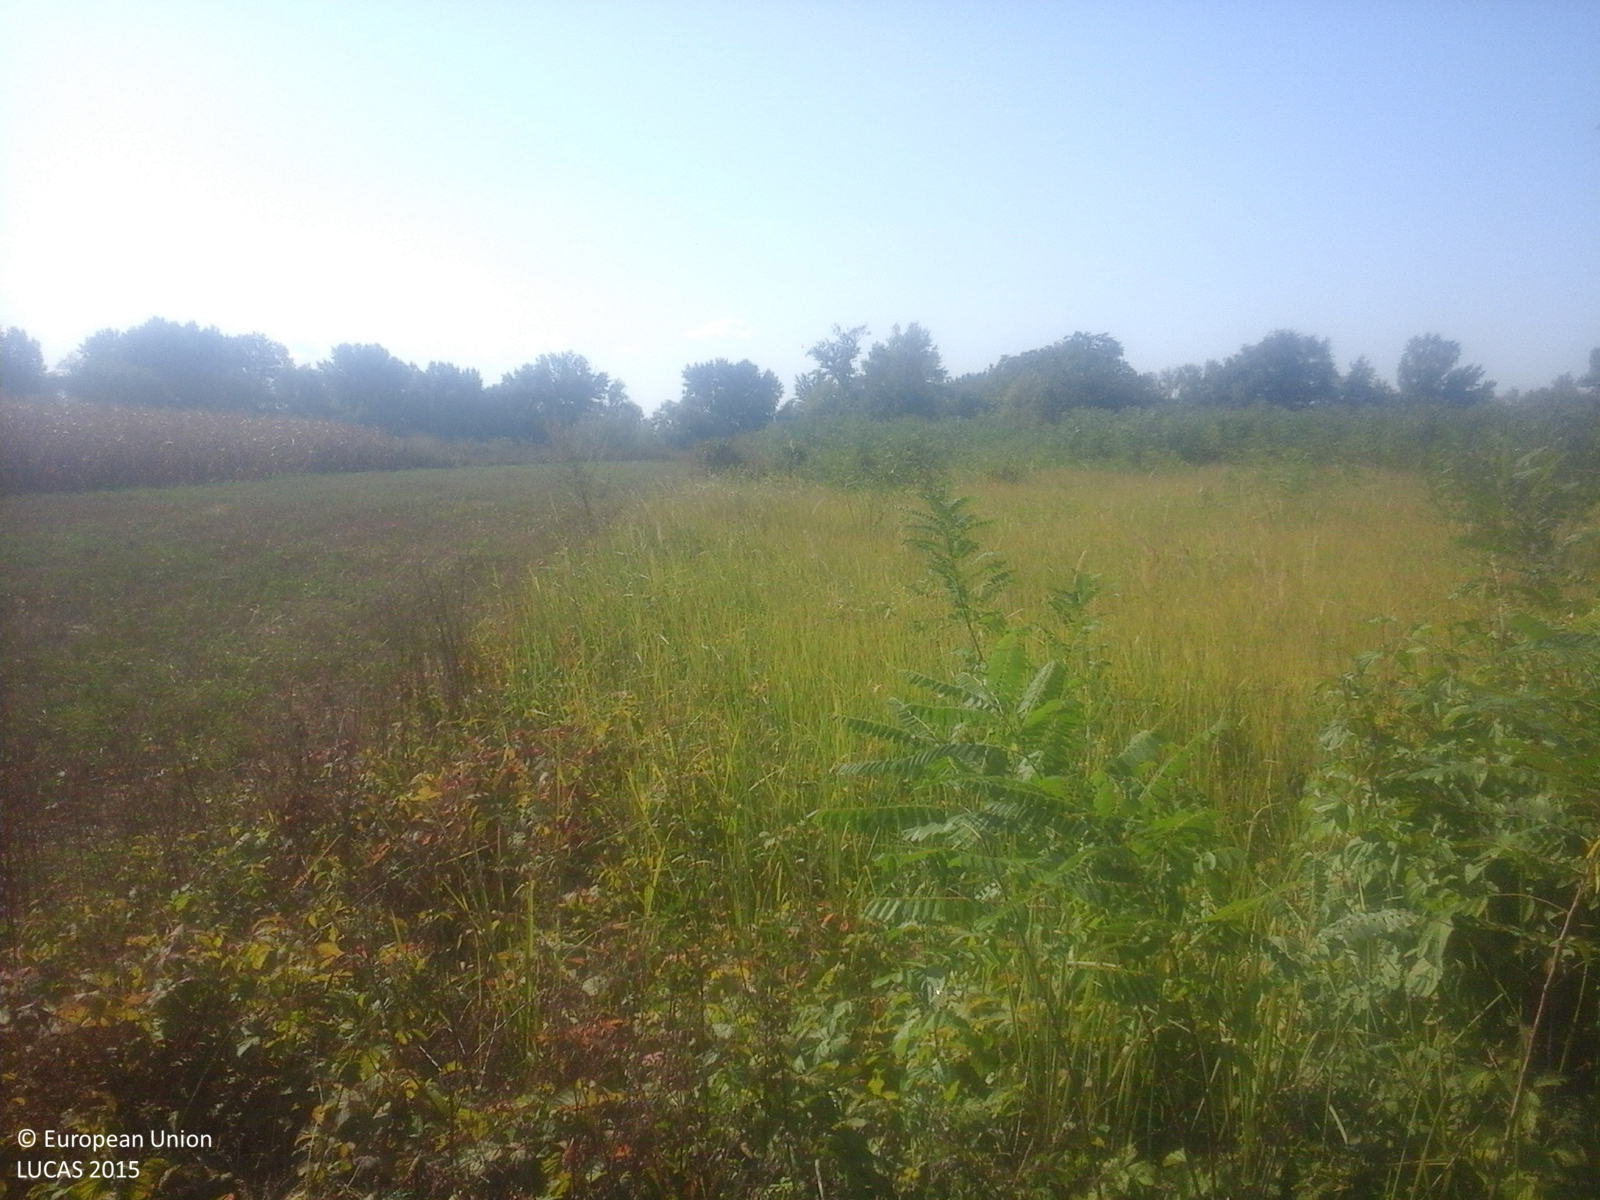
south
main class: Cropland
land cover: Maize
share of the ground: > 75 %
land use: Agriculture (excluding fallow land and kitchen gardens)
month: September
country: RO
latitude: 47.7999
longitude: 22.8140
